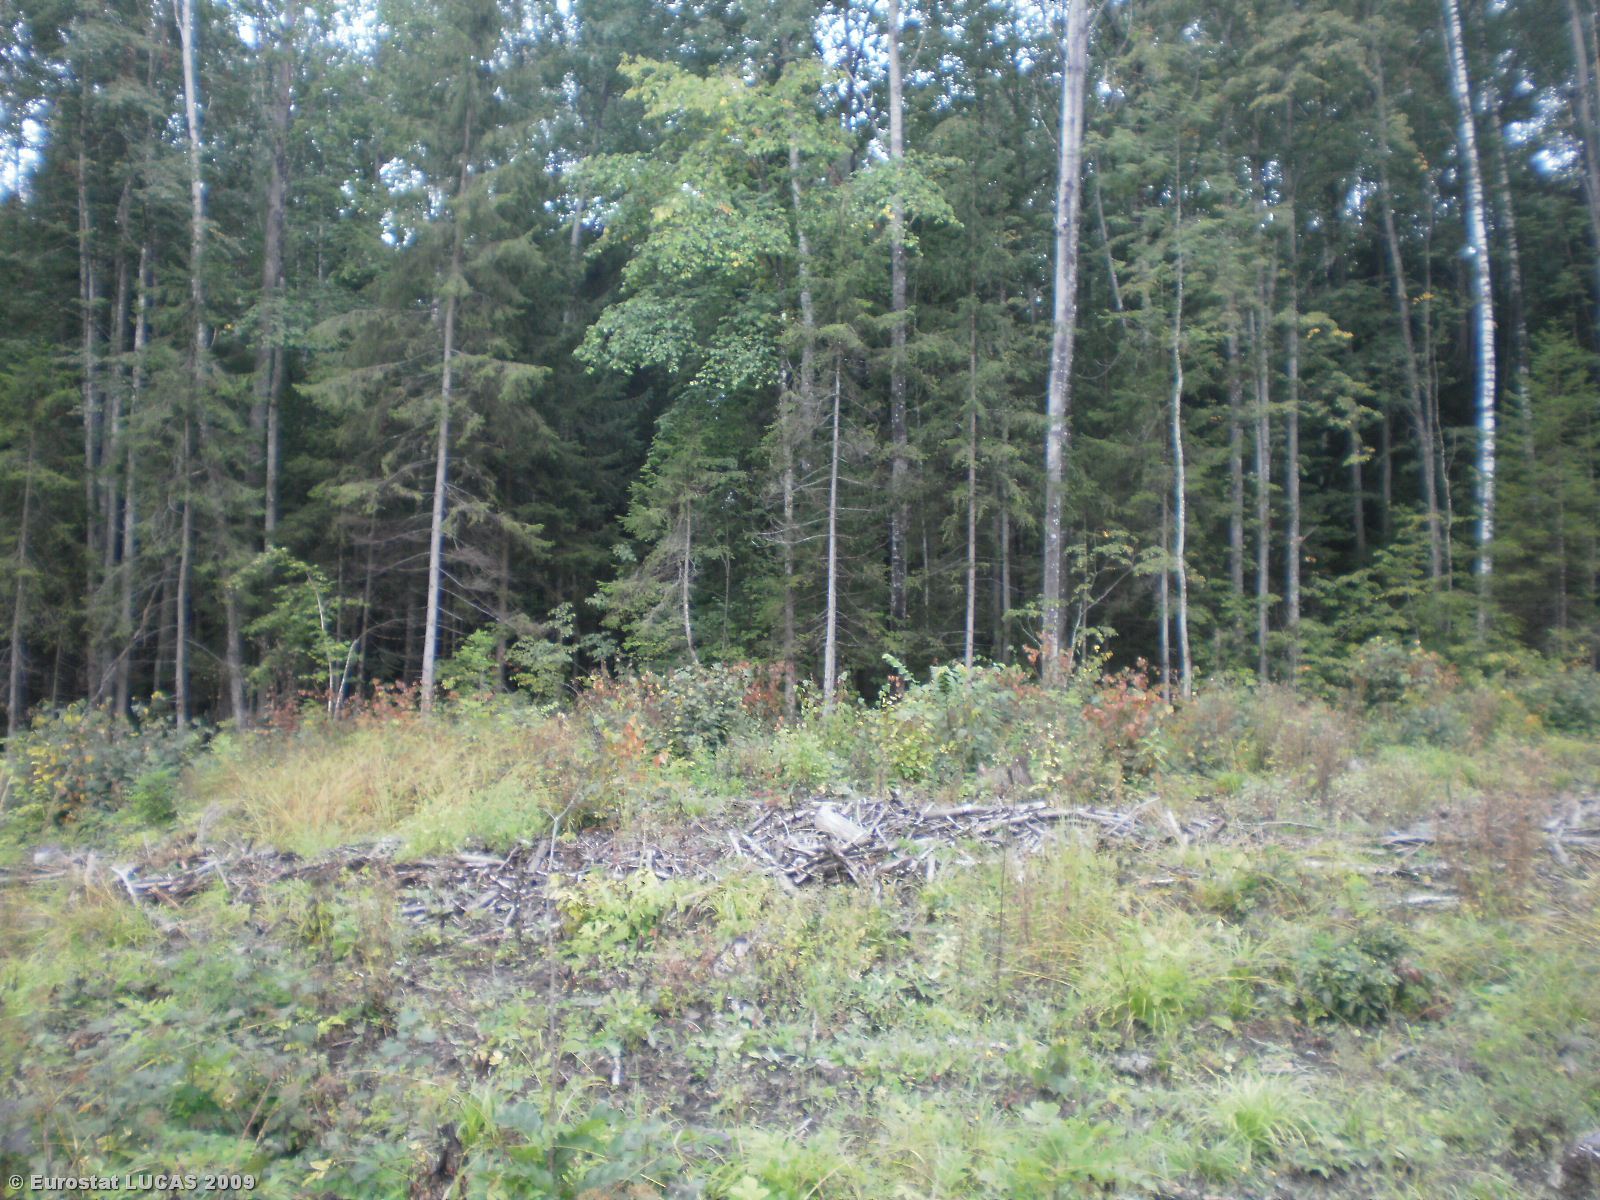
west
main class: Shrubland
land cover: Shrubland with sparse tree cover
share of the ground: > 75 %
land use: Forestry
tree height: > 5 m
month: August
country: LT
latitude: 55.1414
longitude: 25.3874
